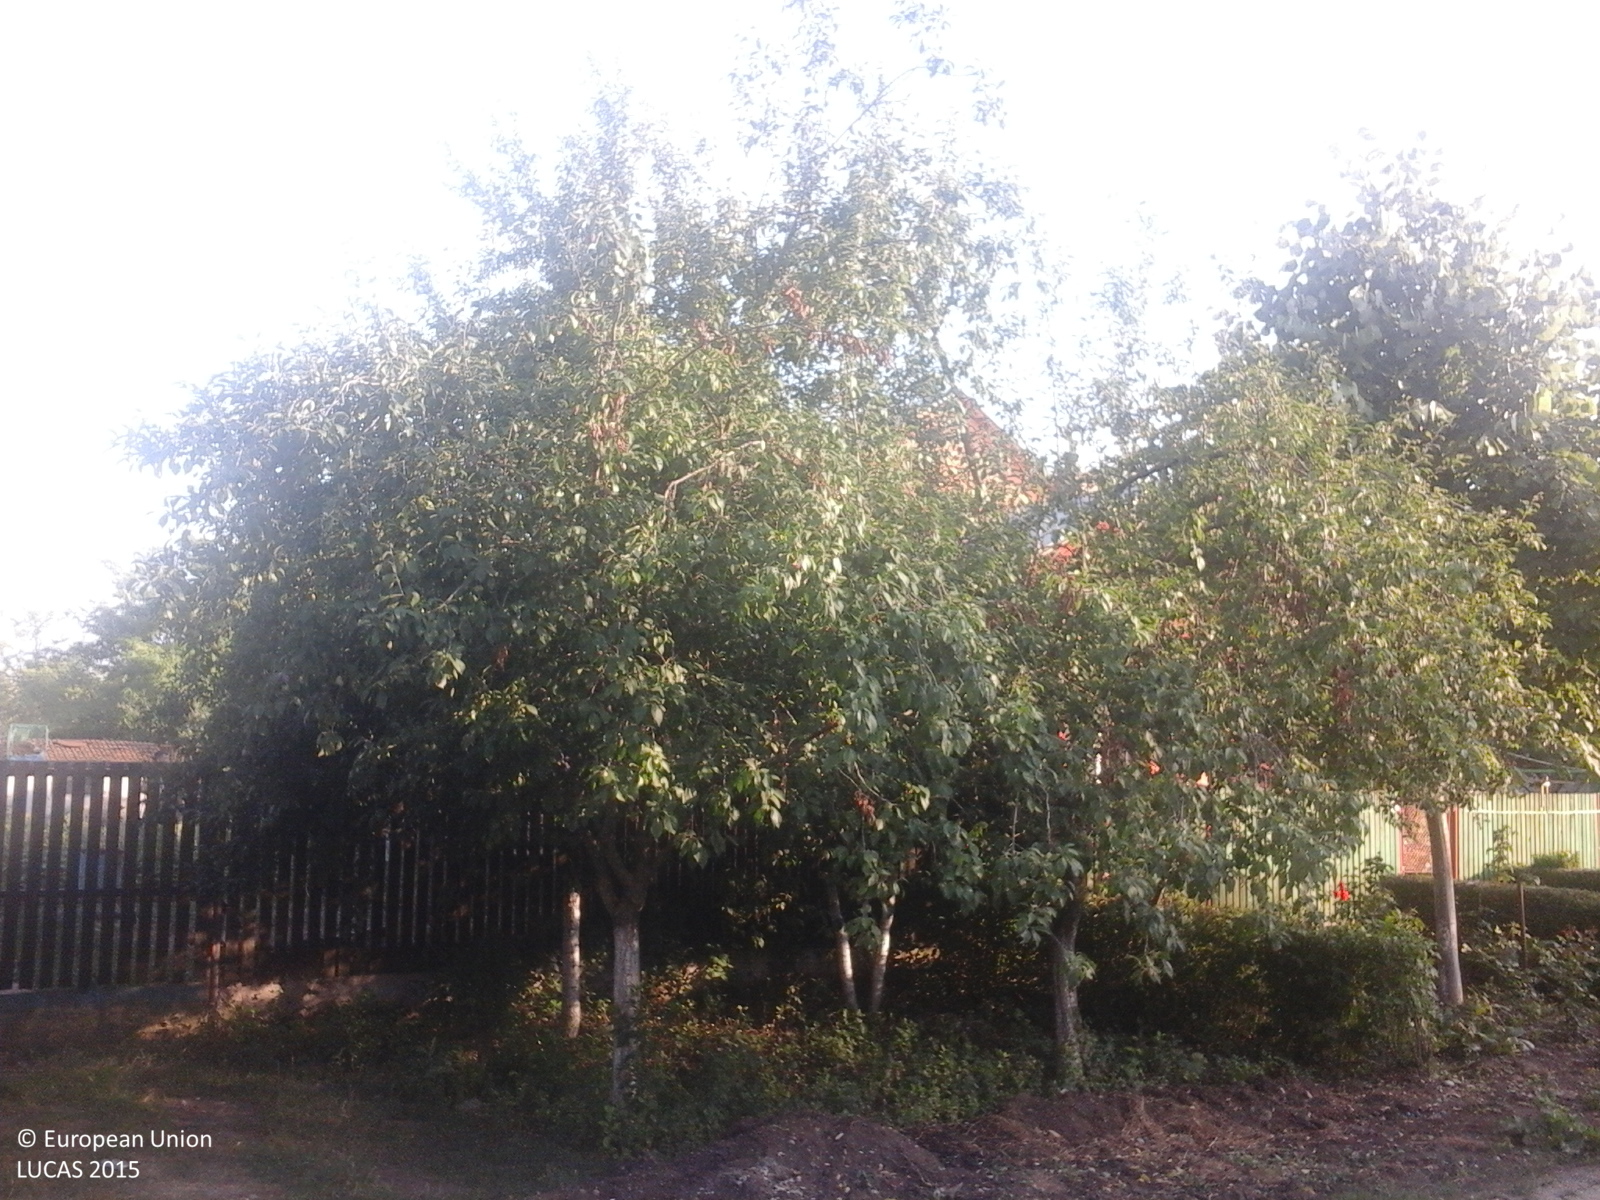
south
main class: Cropland
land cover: Other fresh vegetables
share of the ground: > 75 %
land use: Kitchen garden
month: July
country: RO
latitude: 43.9541
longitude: 25.9344
